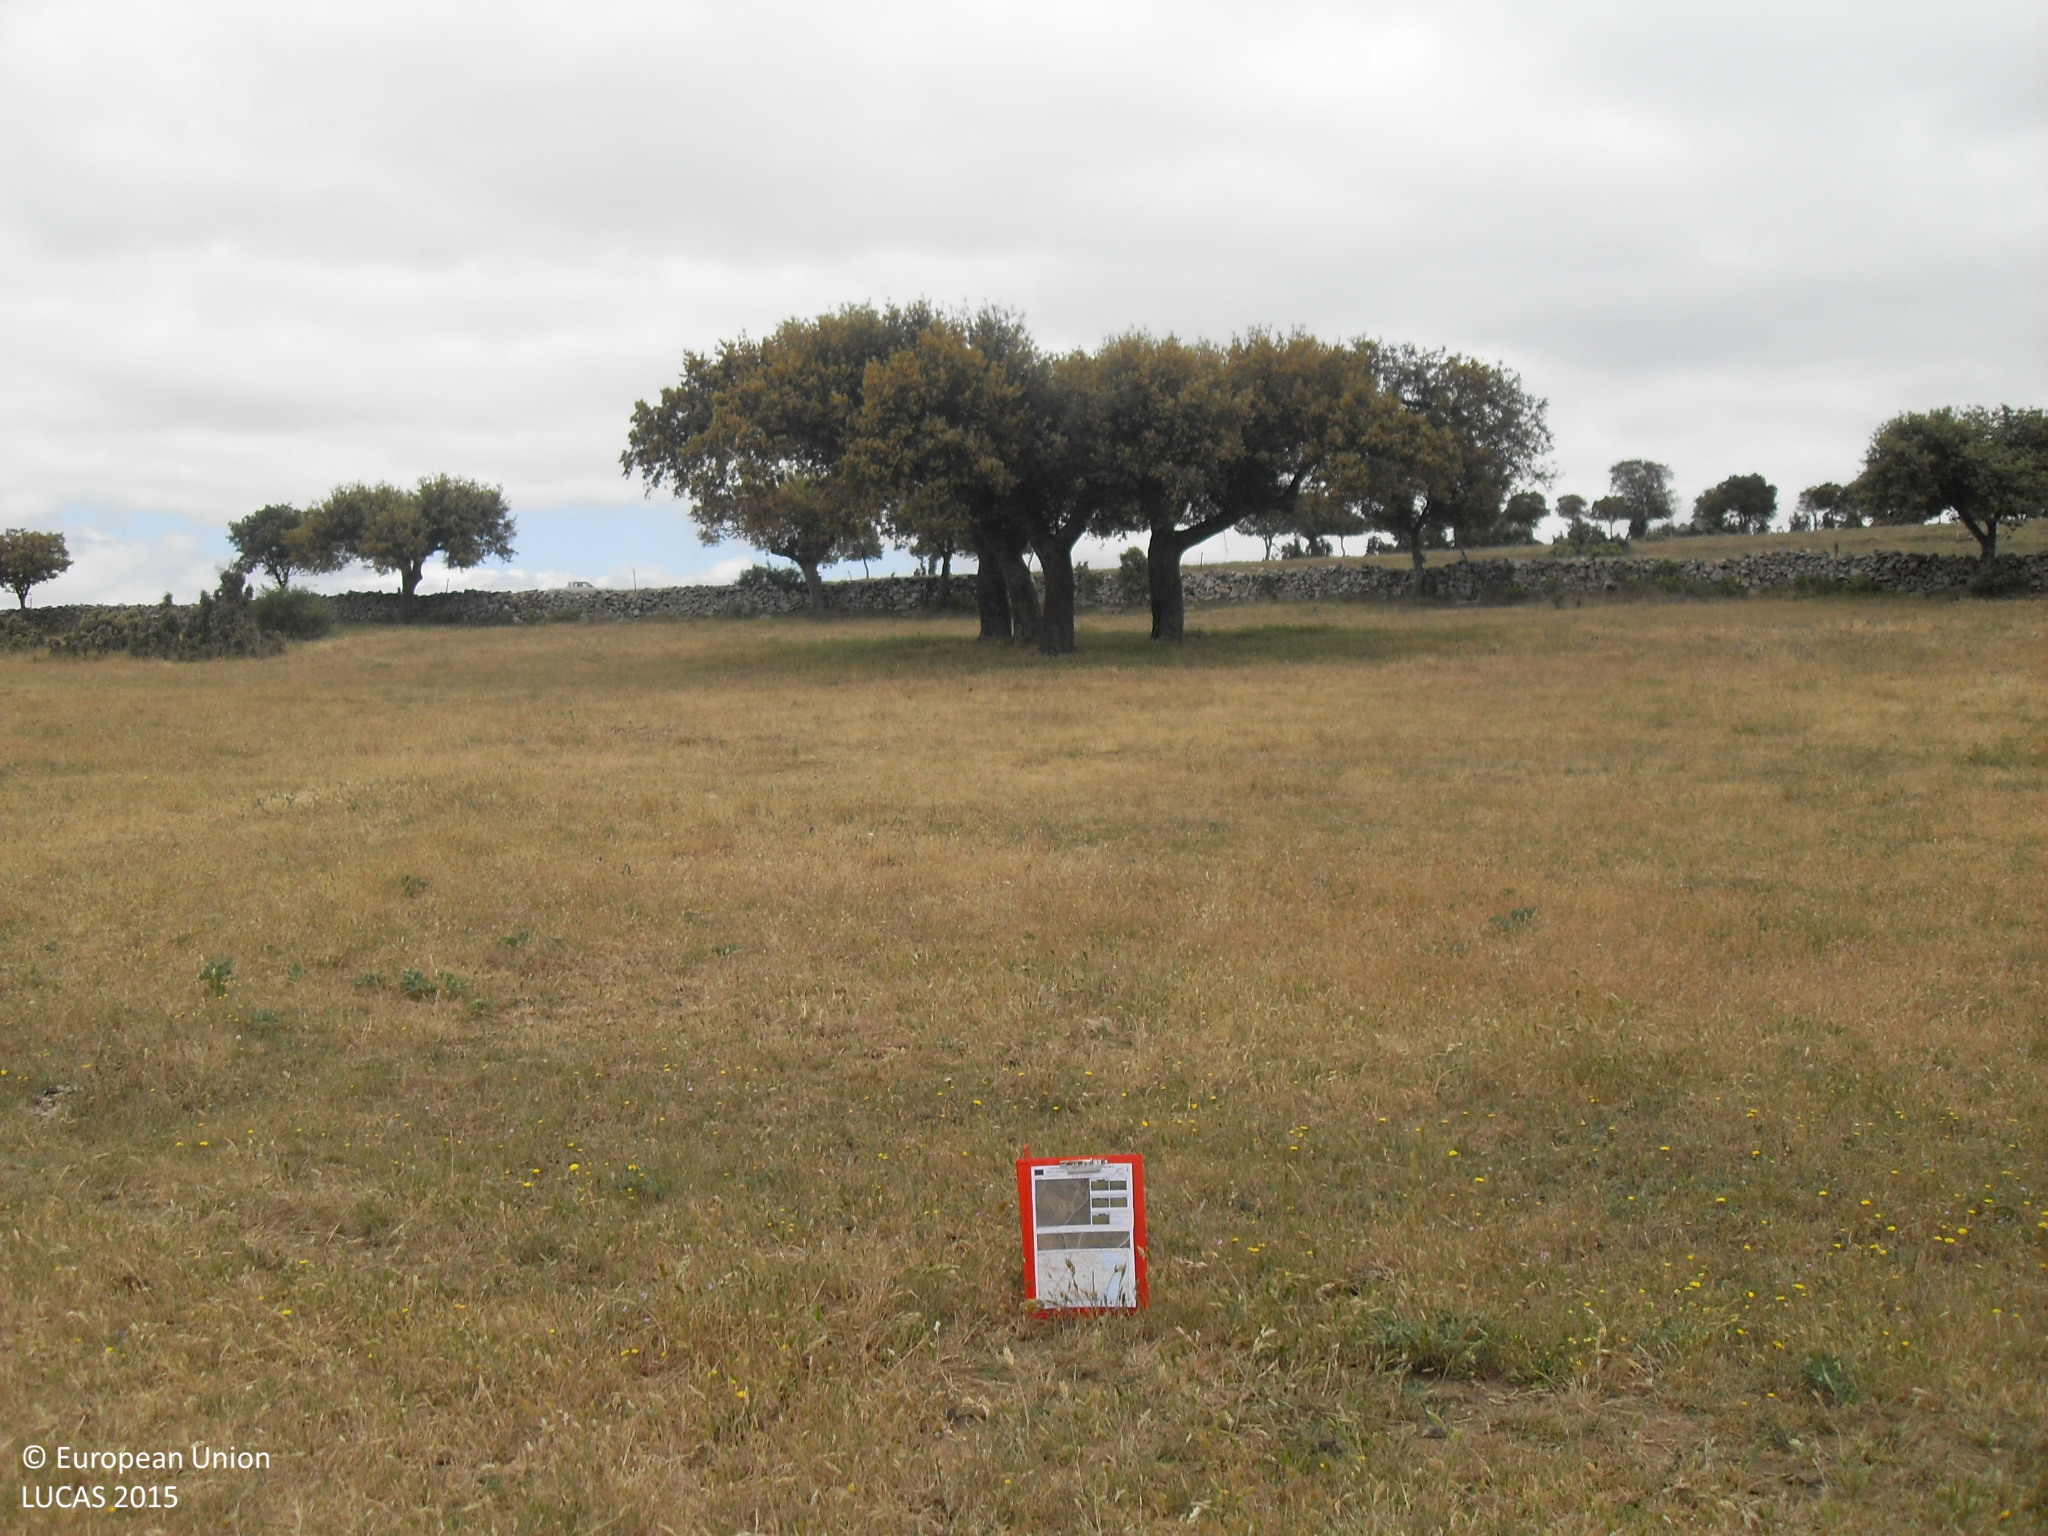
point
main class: Grassland
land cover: Grassland without tree/shrub cover
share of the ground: > 75 %
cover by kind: herbaceous plants 100 %
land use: Agriculture (excluding fallow land and kitchen gardens)
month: May
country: ES
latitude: 40.6081
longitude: -5.6127
